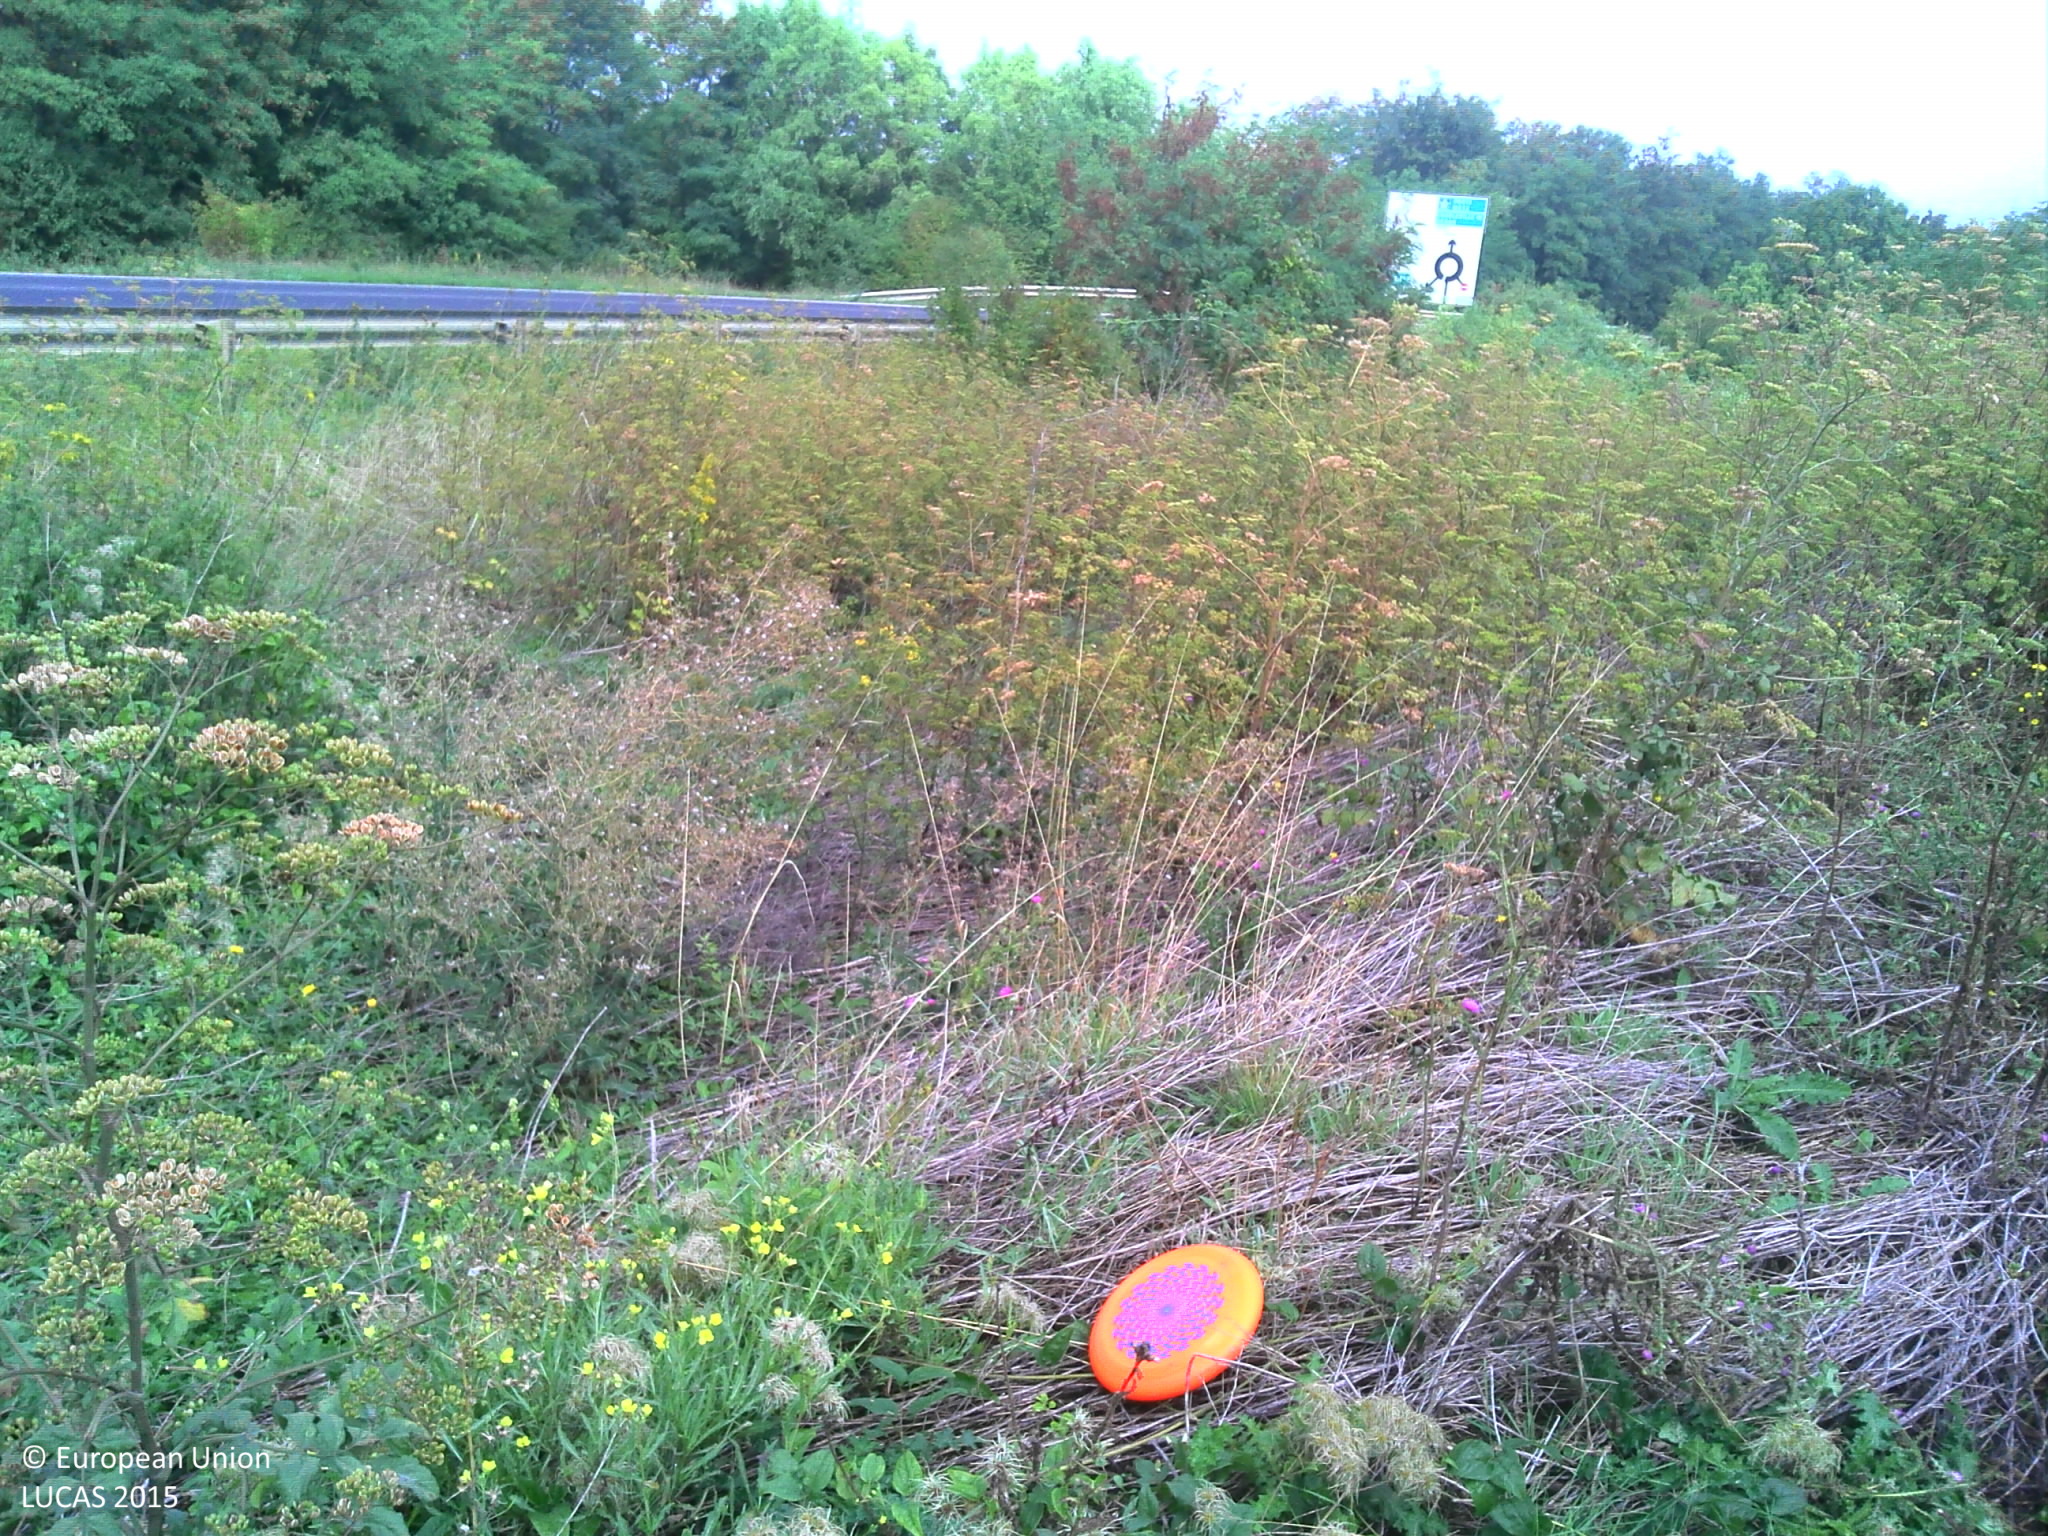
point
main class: Shrubland
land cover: Shrubland without tree cover
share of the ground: 50 - 75 %
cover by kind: shrubs 80 %, herbaceous plants 10 %, consolidated bare surface 5 %, unconsolidated bare surface 5 %
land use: Semi-natural and natural areas not in use
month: September
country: FR
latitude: 49.1770
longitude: 5.9802
